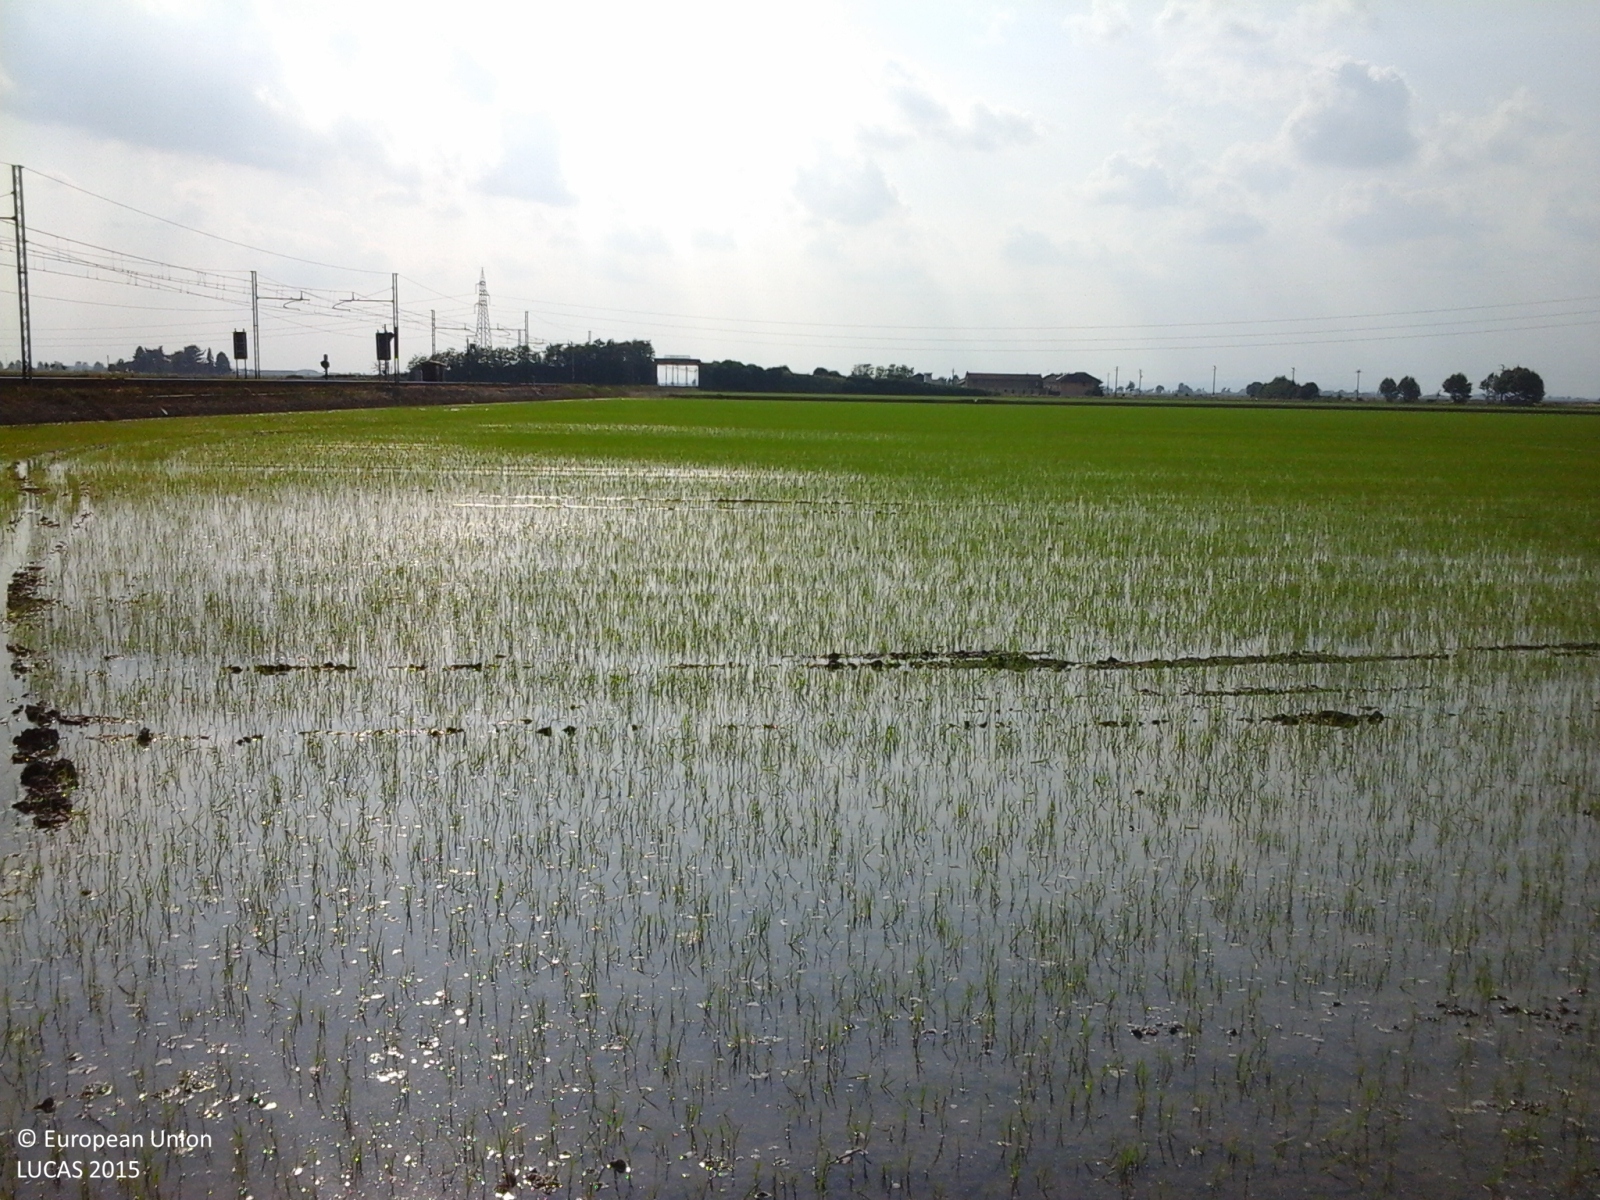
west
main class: Cropland
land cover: Rice
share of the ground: 25 - 50 %
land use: Agriculture (excluding fallow land and kitchen gardens)
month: May
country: IT
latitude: 45.3298
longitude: 8.3824
